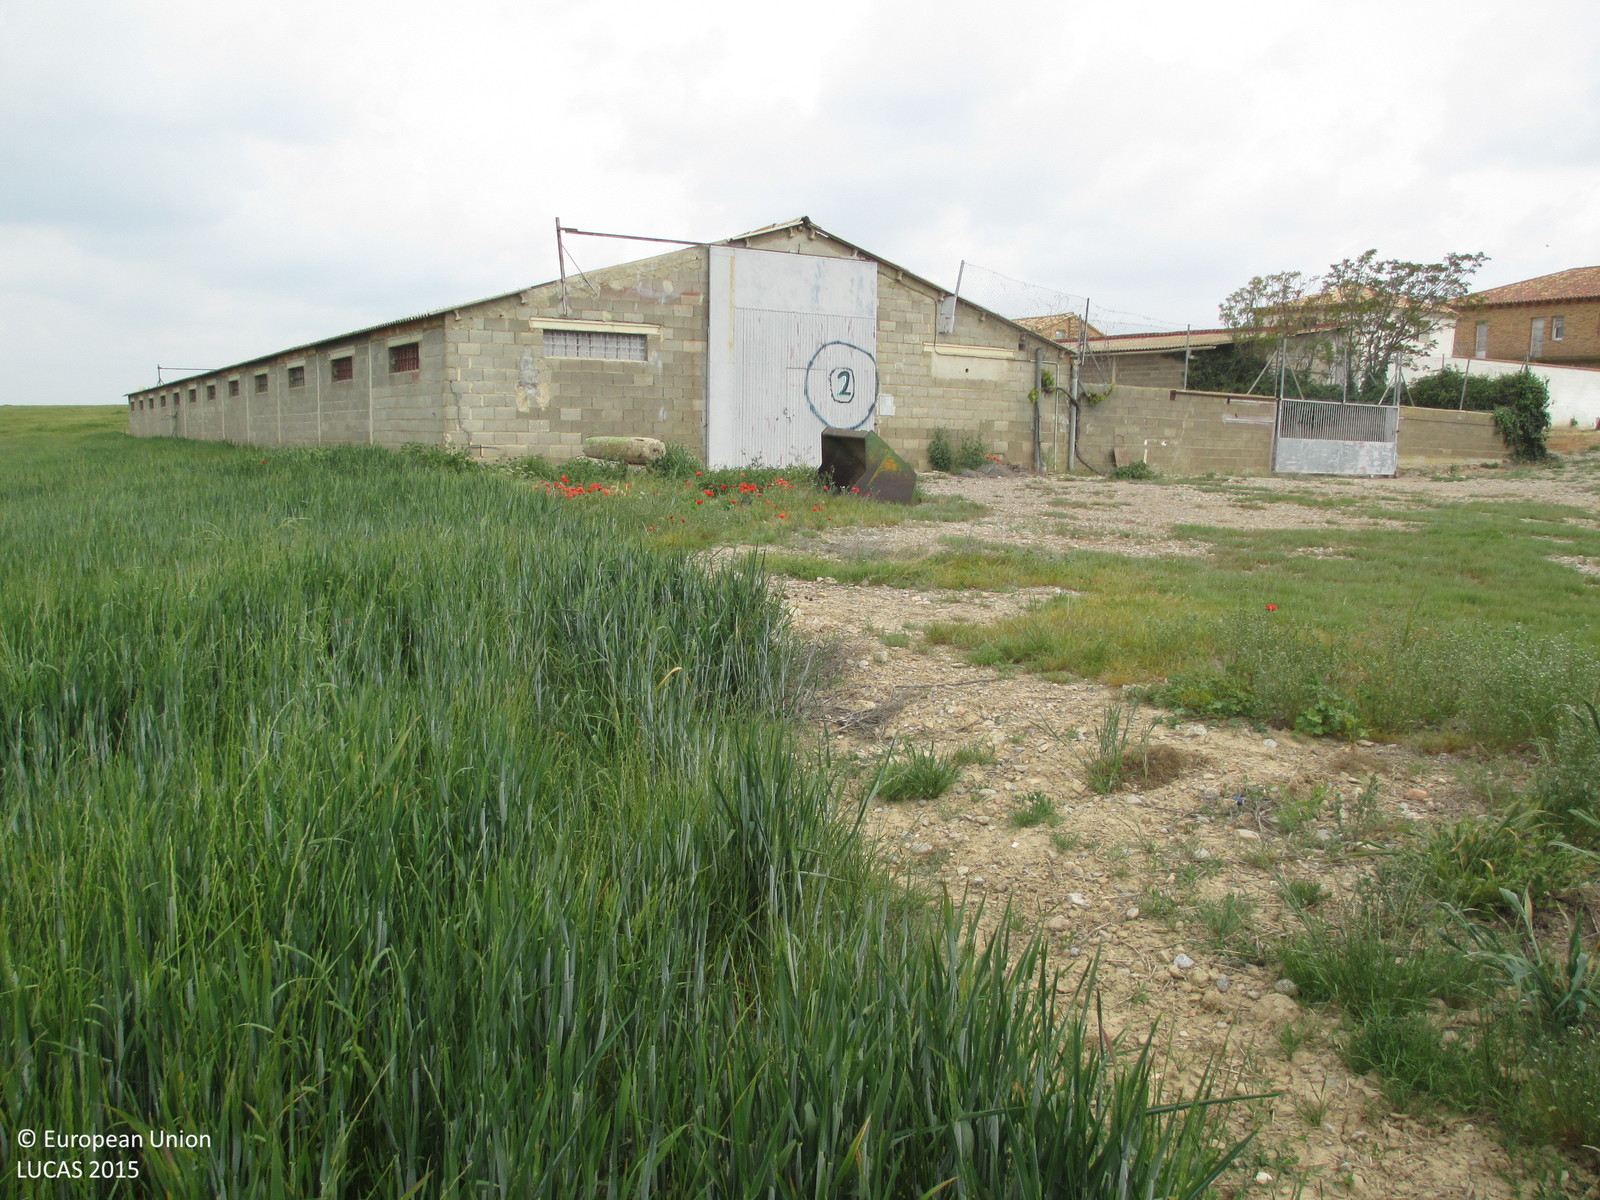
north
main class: Cropland
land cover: Durum wheat
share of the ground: > 75 %
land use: Agriculture (excluding fallow land and kitchen gardens)
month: April
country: ES
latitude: 42.0981
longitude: -0.4087
